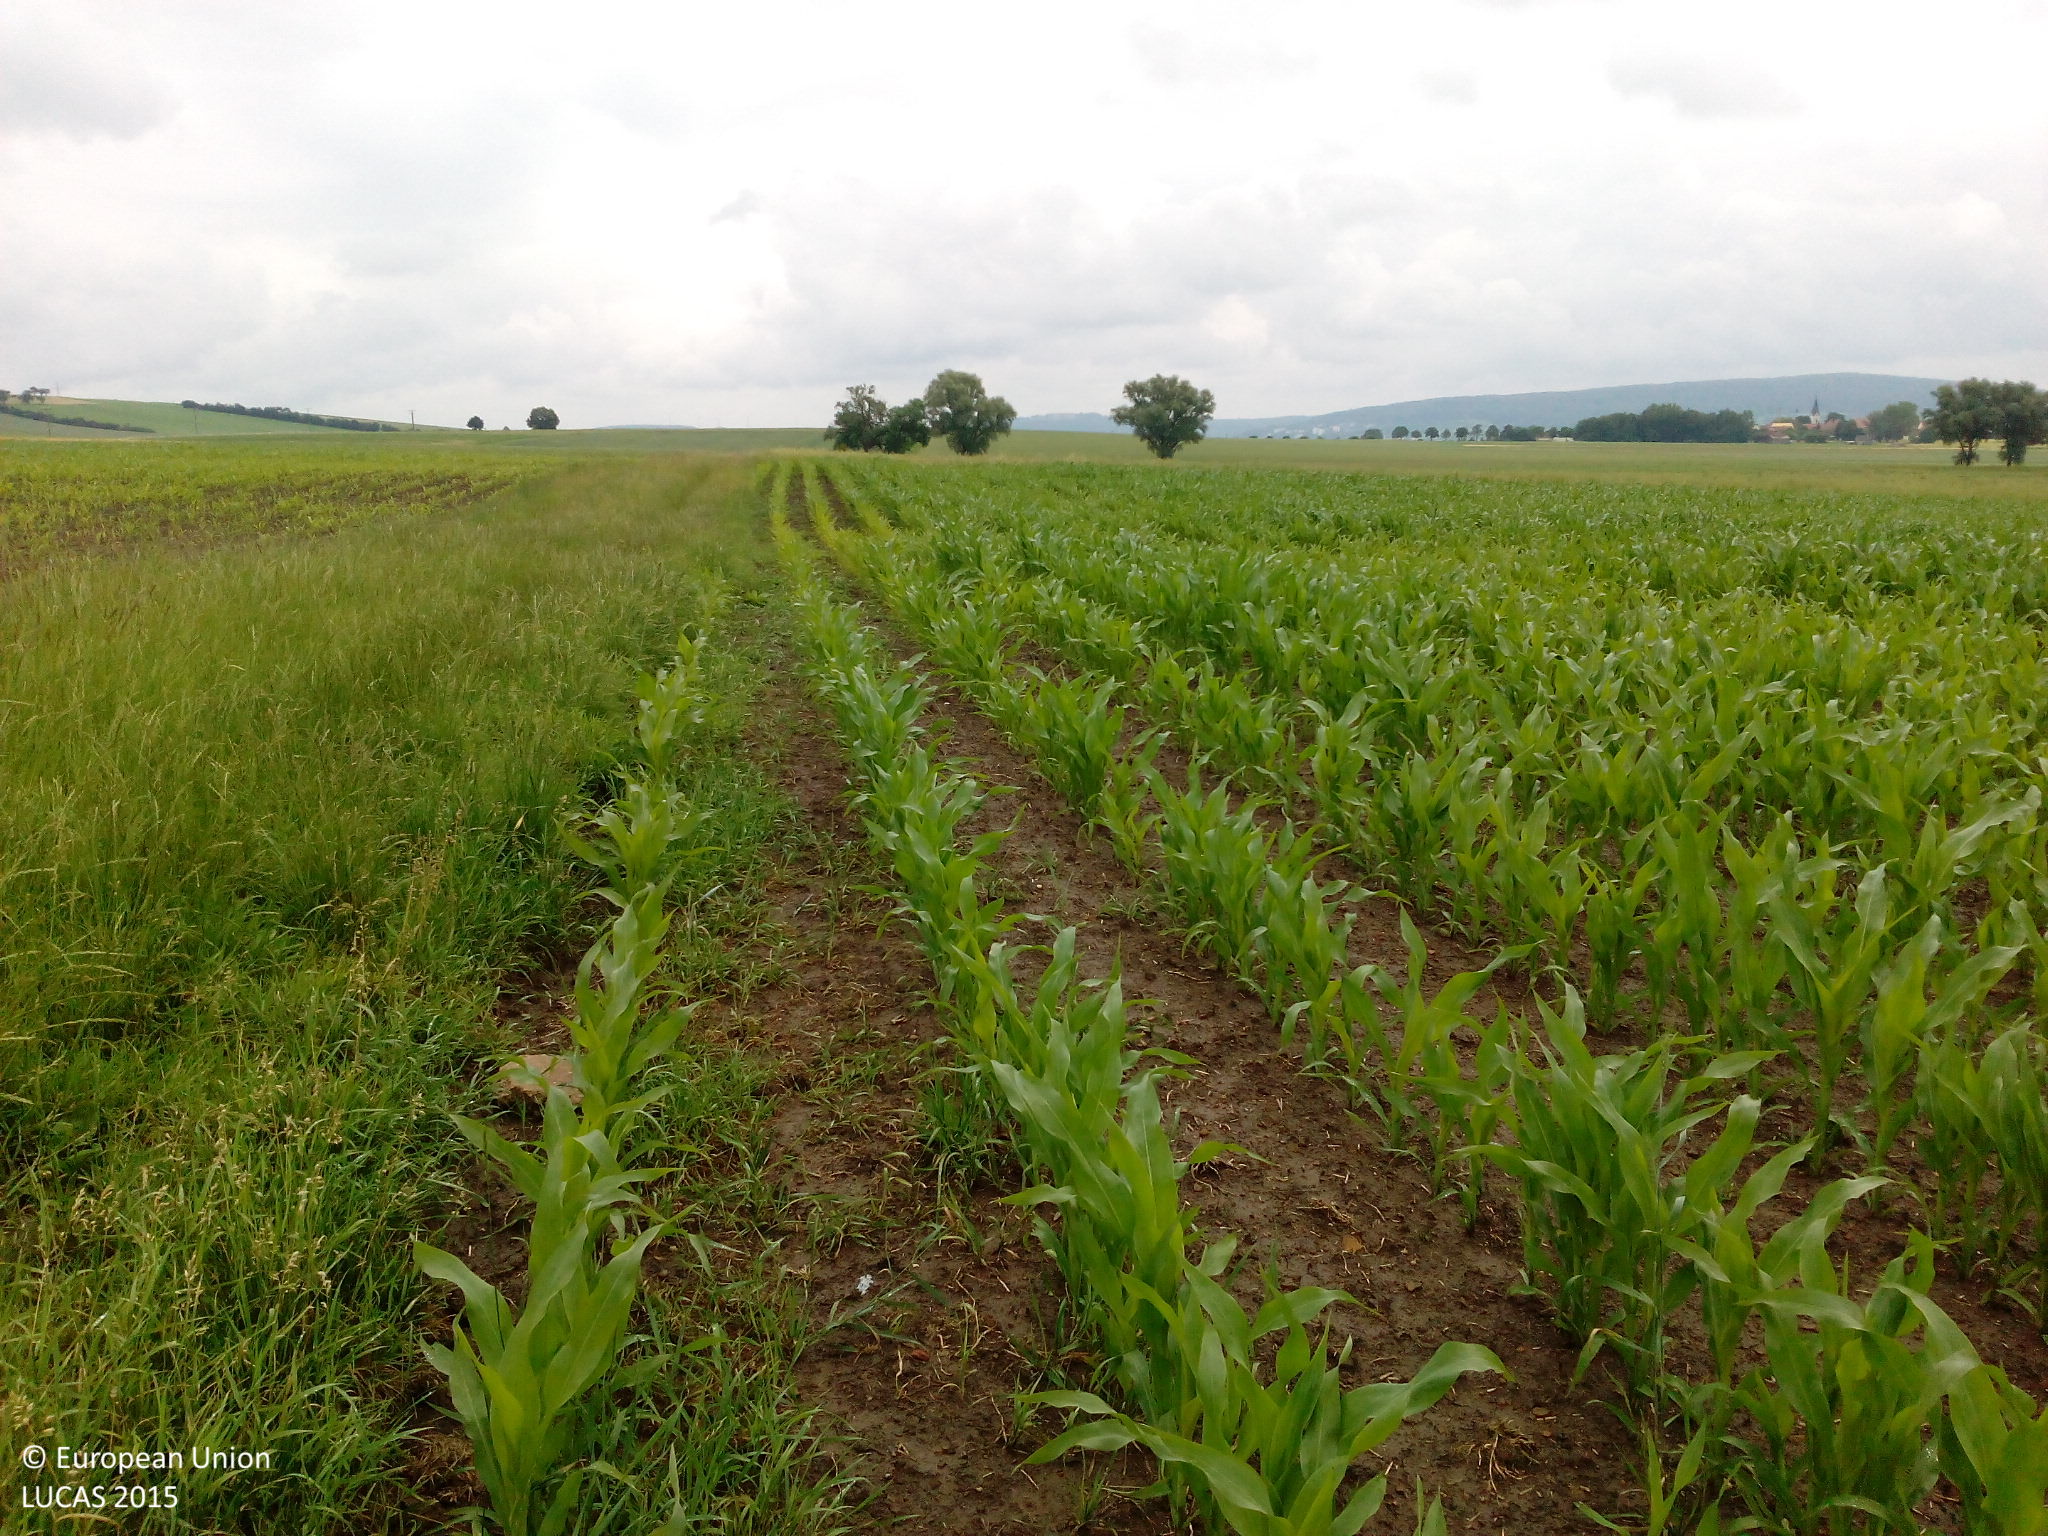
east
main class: Cropland
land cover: Maize
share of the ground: < 10 %
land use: Agriculture (excluding fallow land and kitchen gardens)
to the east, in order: Rape and turnip rape; Maize; Grassland without tree/shrub cover; Oats
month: June
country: DE
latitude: 49.0296
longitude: 10.8886
